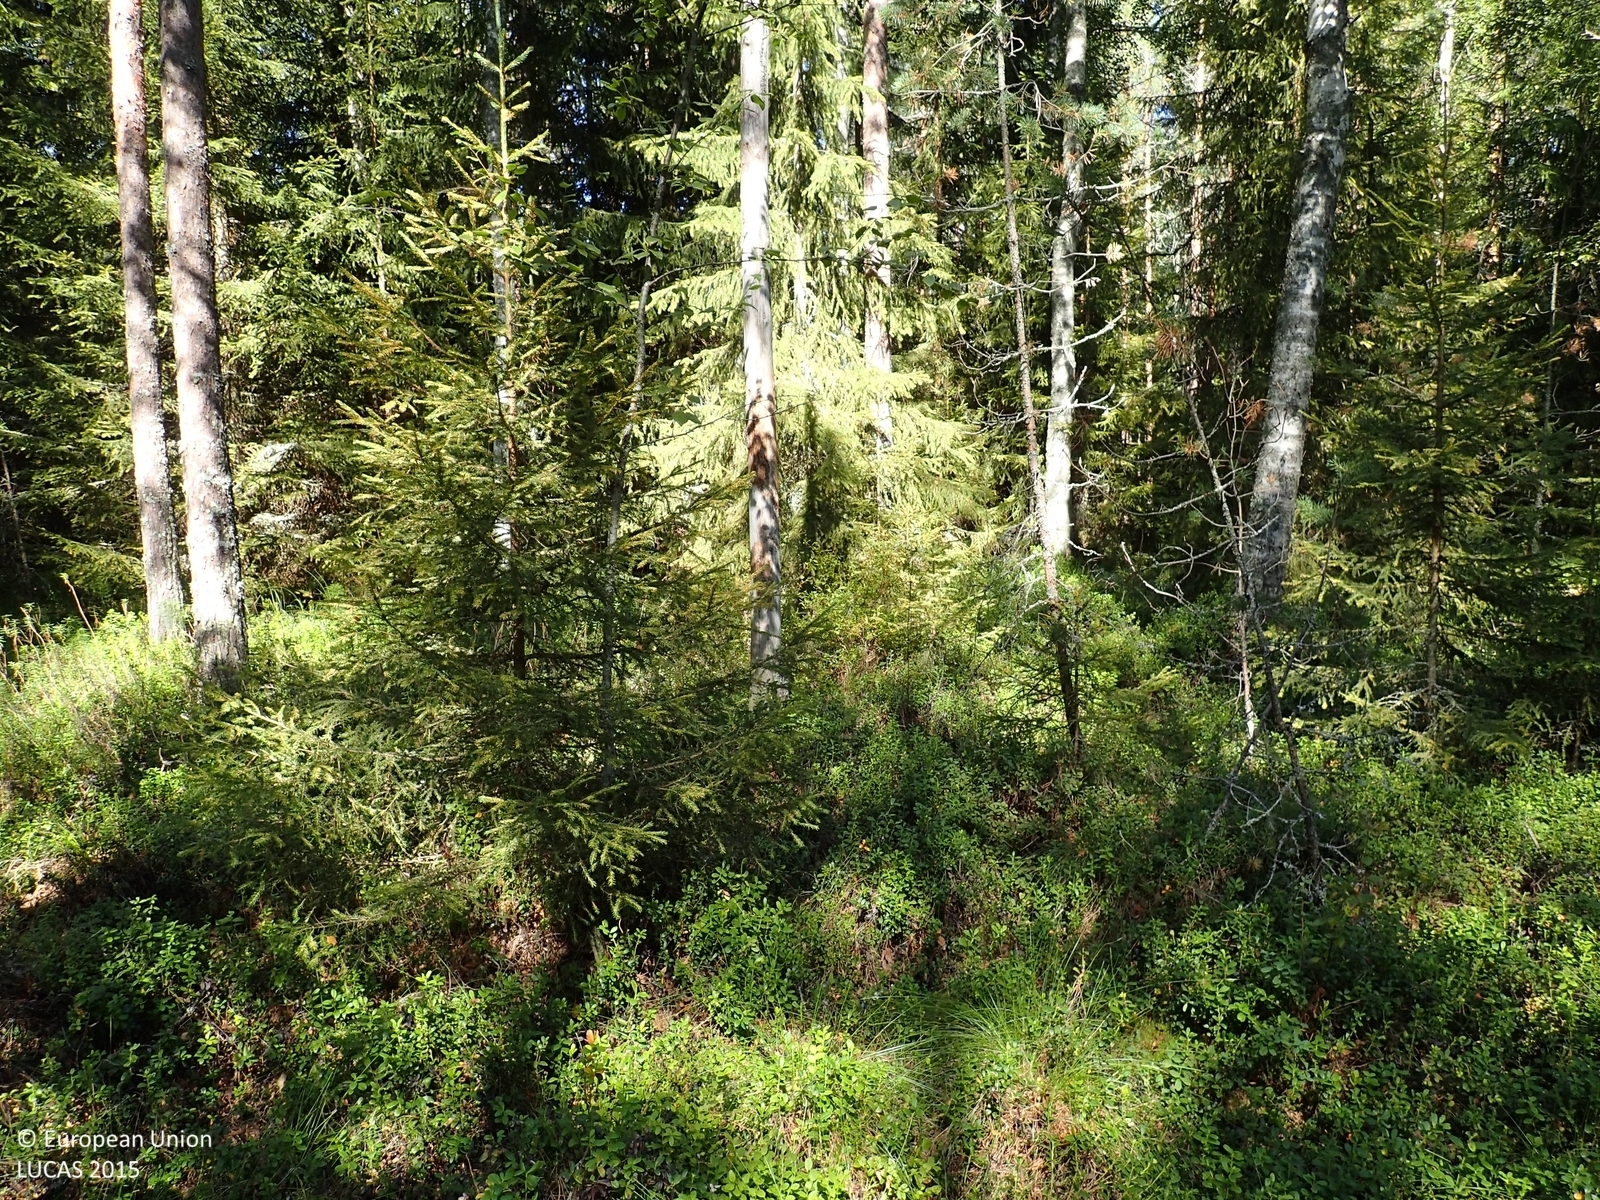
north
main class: Woodland
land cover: Other mixed woodland
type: boreal forest
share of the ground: > 75 %
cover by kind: coniferous forest trees 55 %, shrubs 25 %, broadleaved forest trees 20 %
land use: Forestry
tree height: > 5 m
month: August
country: FI
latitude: 62.5305
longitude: 22.4724
